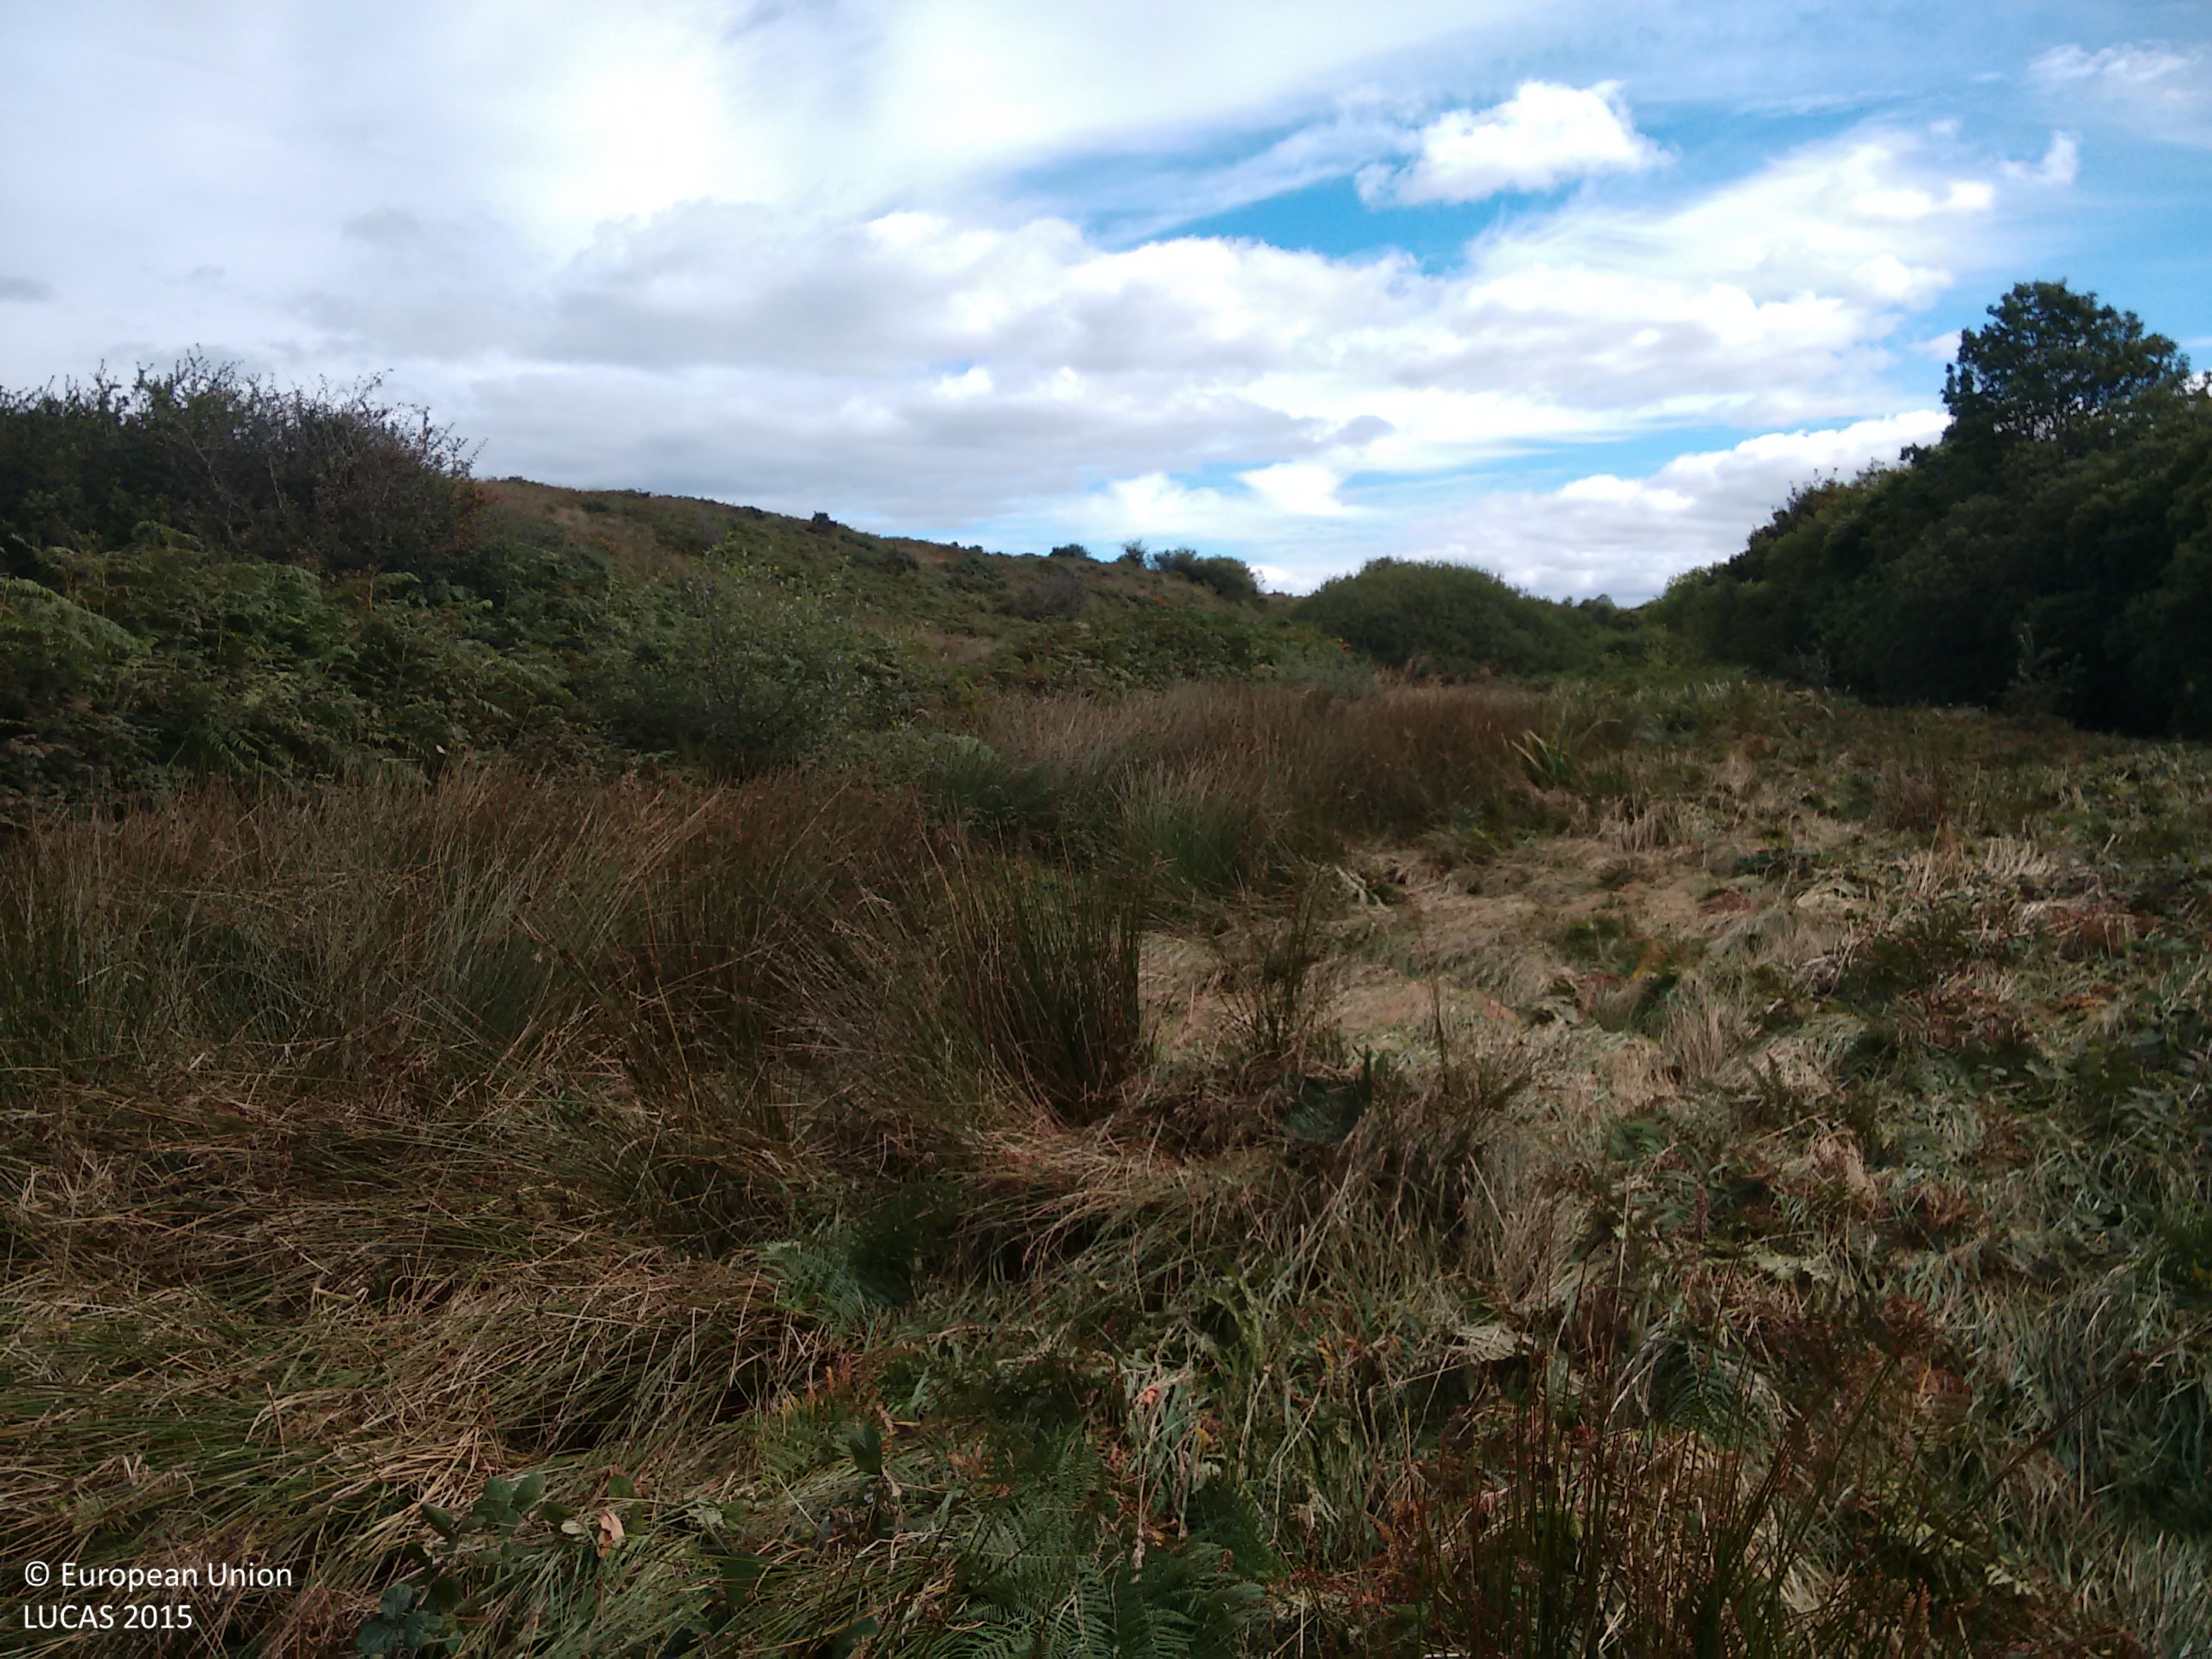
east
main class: Grassland
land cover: Grassland with sparse tree/shrub cover
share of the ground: > 75 %
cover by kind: herbaceous plants 90 %, broadleaved forest trees 5 %, shrubs 5 %
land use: Agriculture (excluding fallow land and kitchen gardens)
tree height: < 5 m
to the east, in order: Grassland with sparse tree/shrub cover; Shrubland with sparse tree cover; Grassland with sparse tree/shrub cover; Shrubland without tree cover; Grassland without tree/shrub cover; Abandoned hedges; Ditches and canals; Grassland without tree/shrub cover; Grassland with sparse tree/shrub cover; Peatbogs
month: September
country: IE
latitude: 52.3914
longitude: -9.4669
